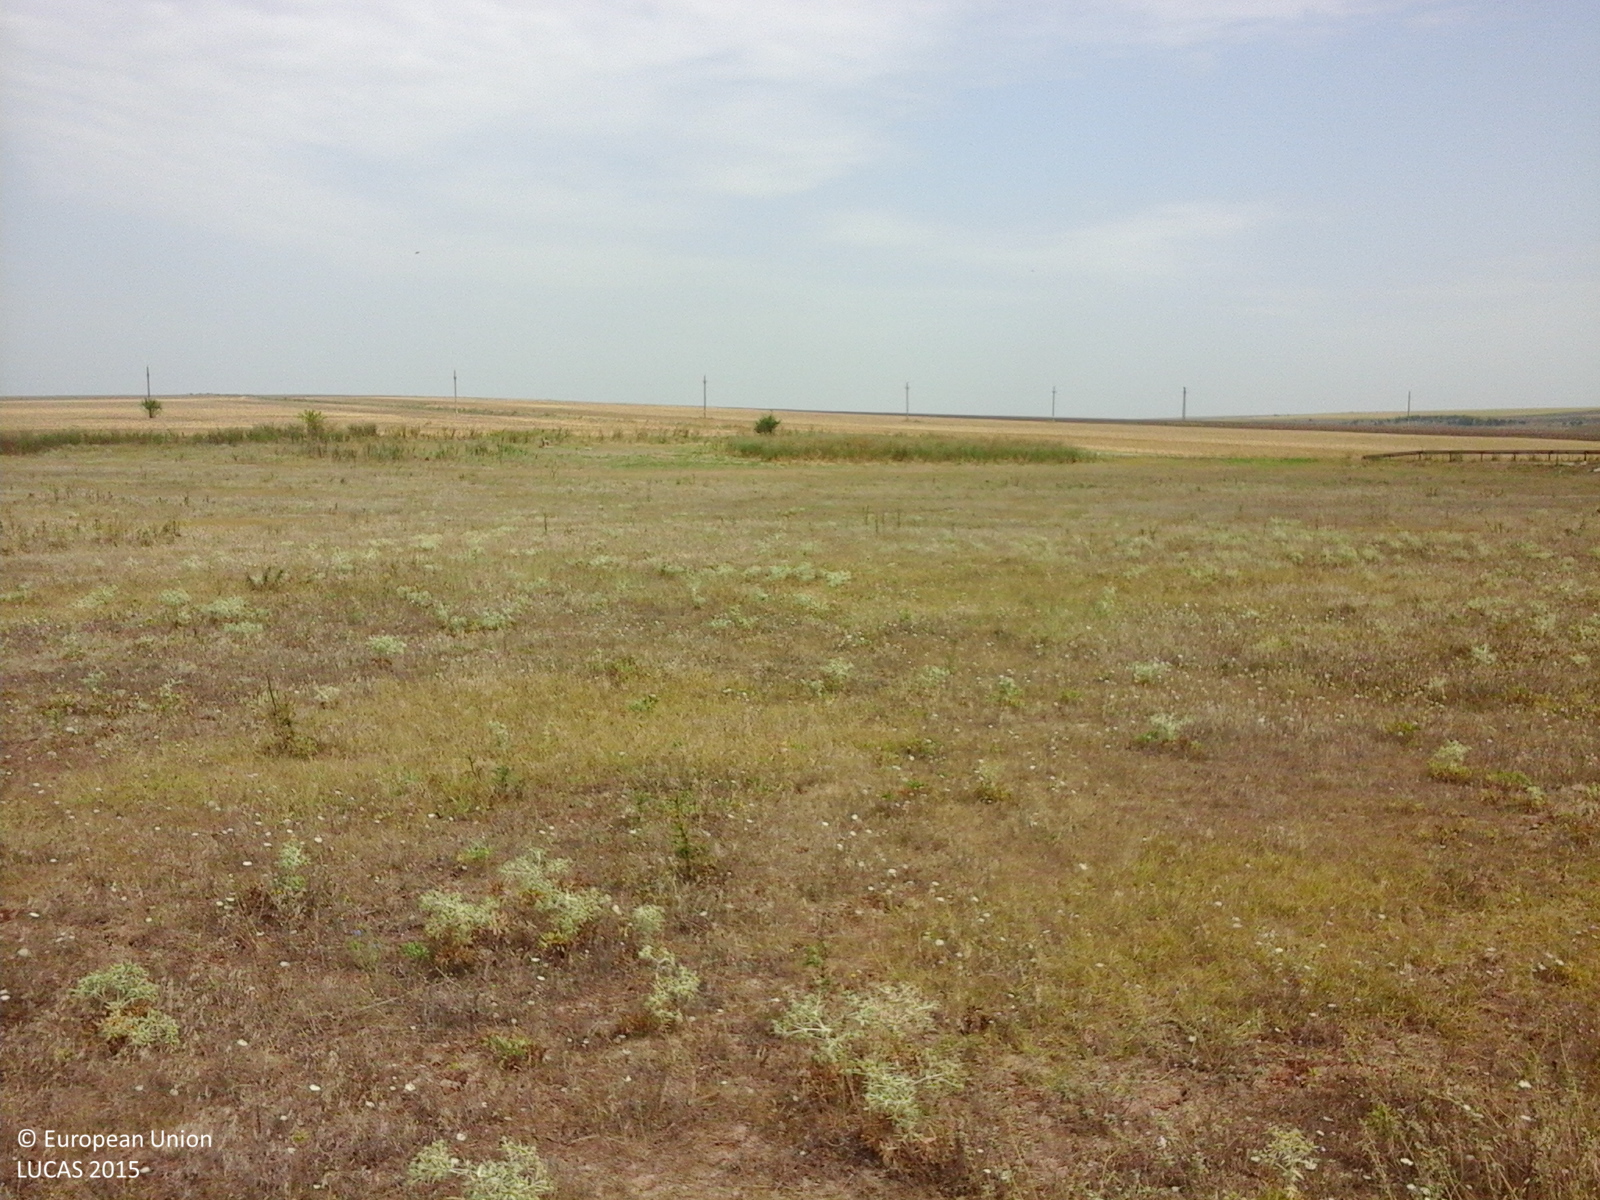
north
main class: Grassland
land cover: Spontaneously vegetated surfaces
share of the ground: > 75 %
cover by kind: herbaceous plants 100 %
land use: Fallow land
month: August
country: RO
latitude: 43.7879
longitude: 28.3400
